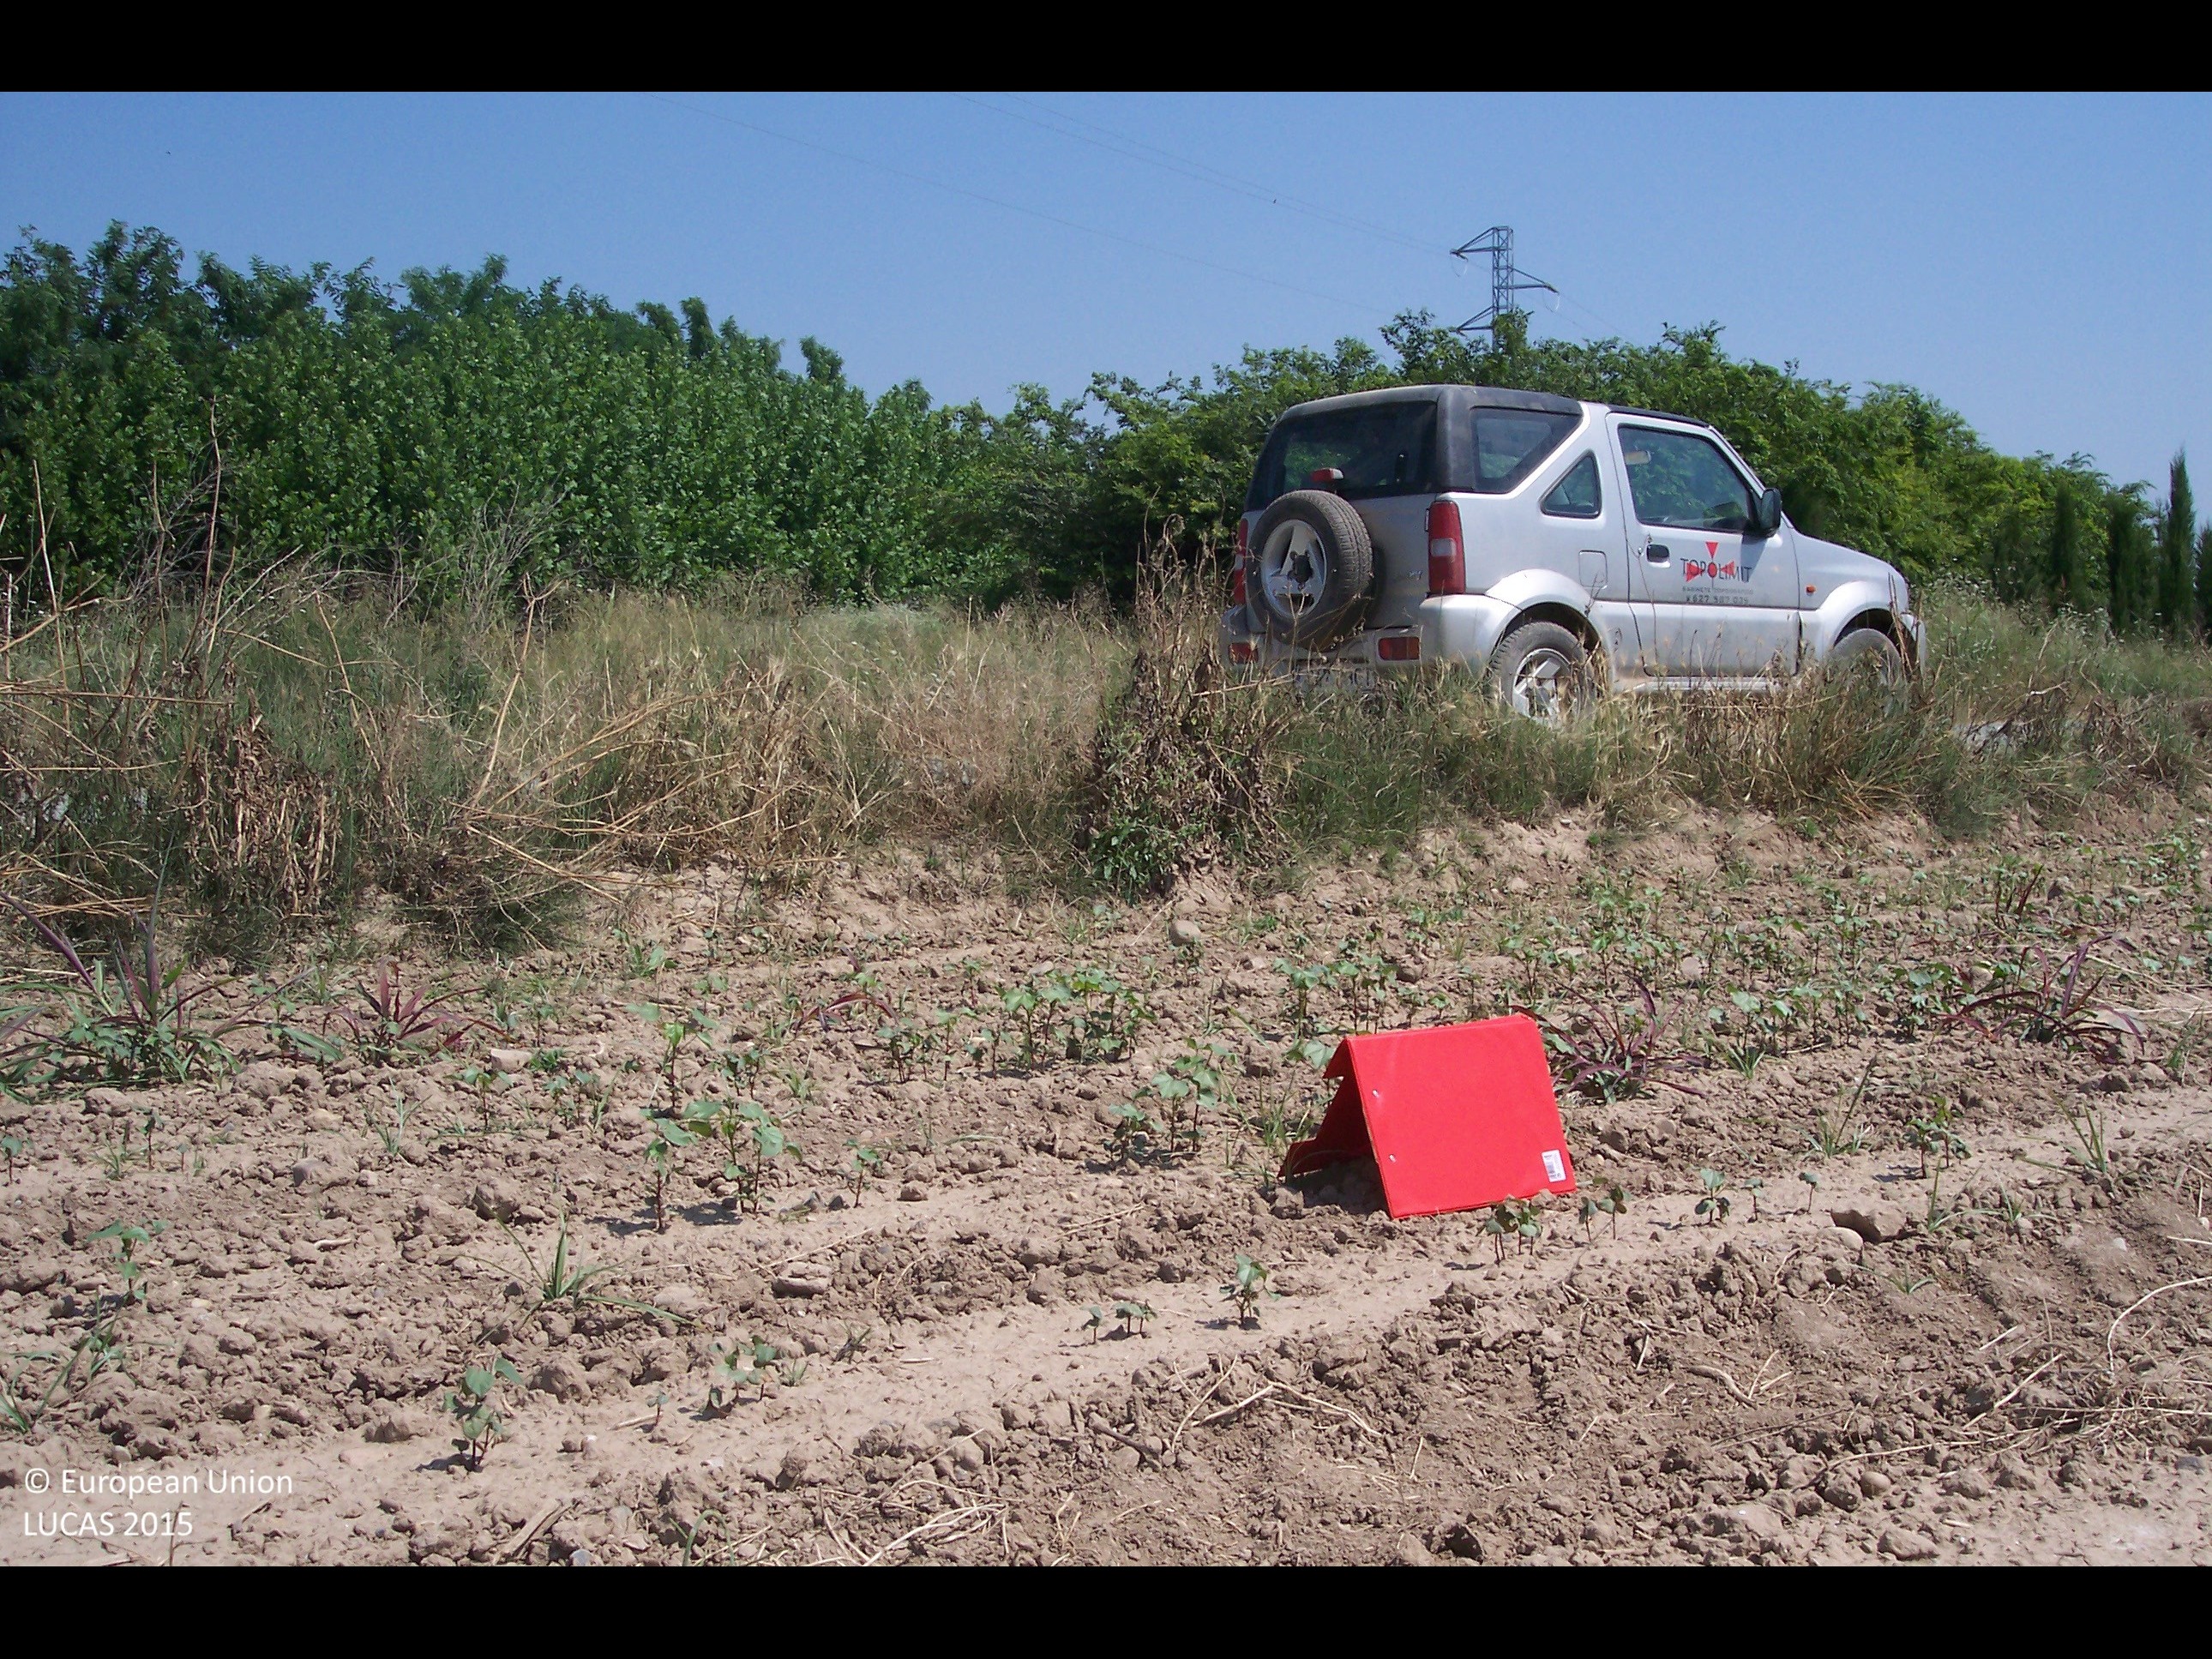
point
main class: Cropland
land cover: Cotton
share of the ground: < 10 %
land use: Agriculture (excluding fallow land and kitchen gardens)
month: May
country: ES
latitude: 37.5389
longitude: -5.9264
